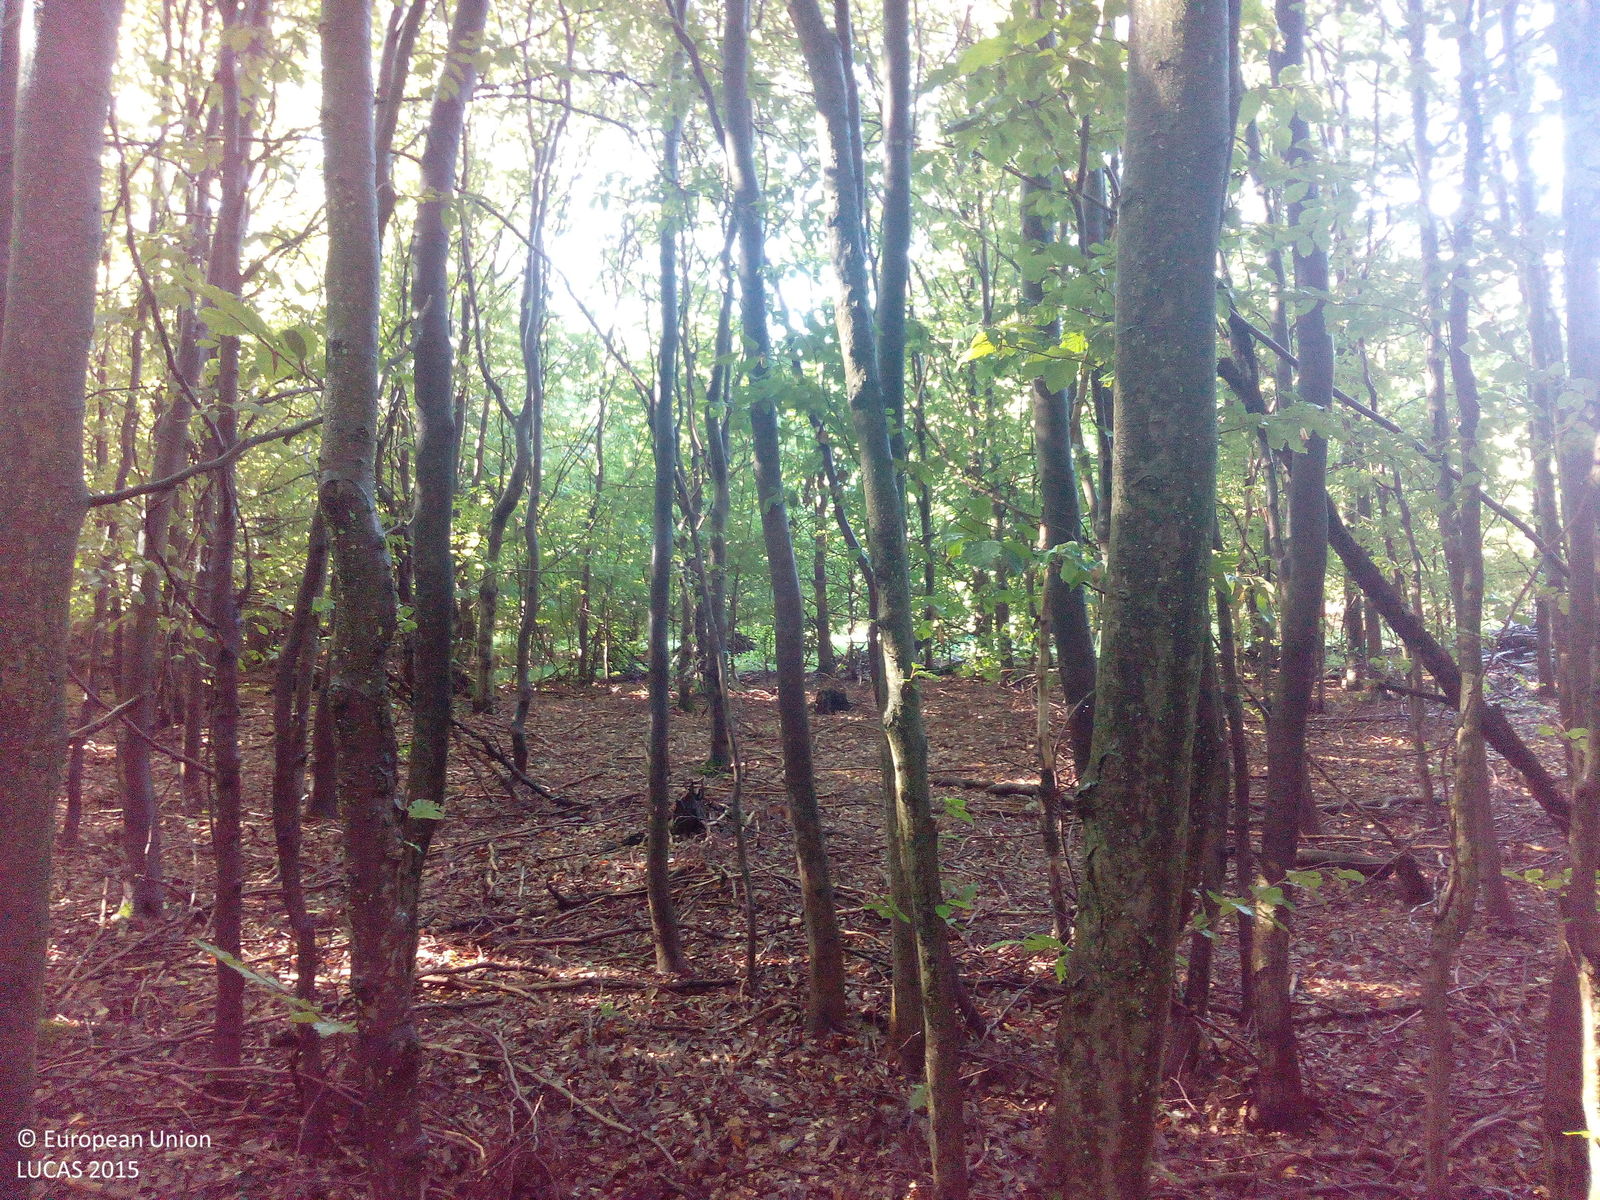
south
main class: Woodland
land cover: Broadleaved woodland
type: beech forest
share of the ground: > 75 %
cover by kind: broadleaved forest trees 100 %
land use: Forestry
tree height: > 5 m
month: August
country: DE
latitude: 51.7086
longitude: 10.9404
